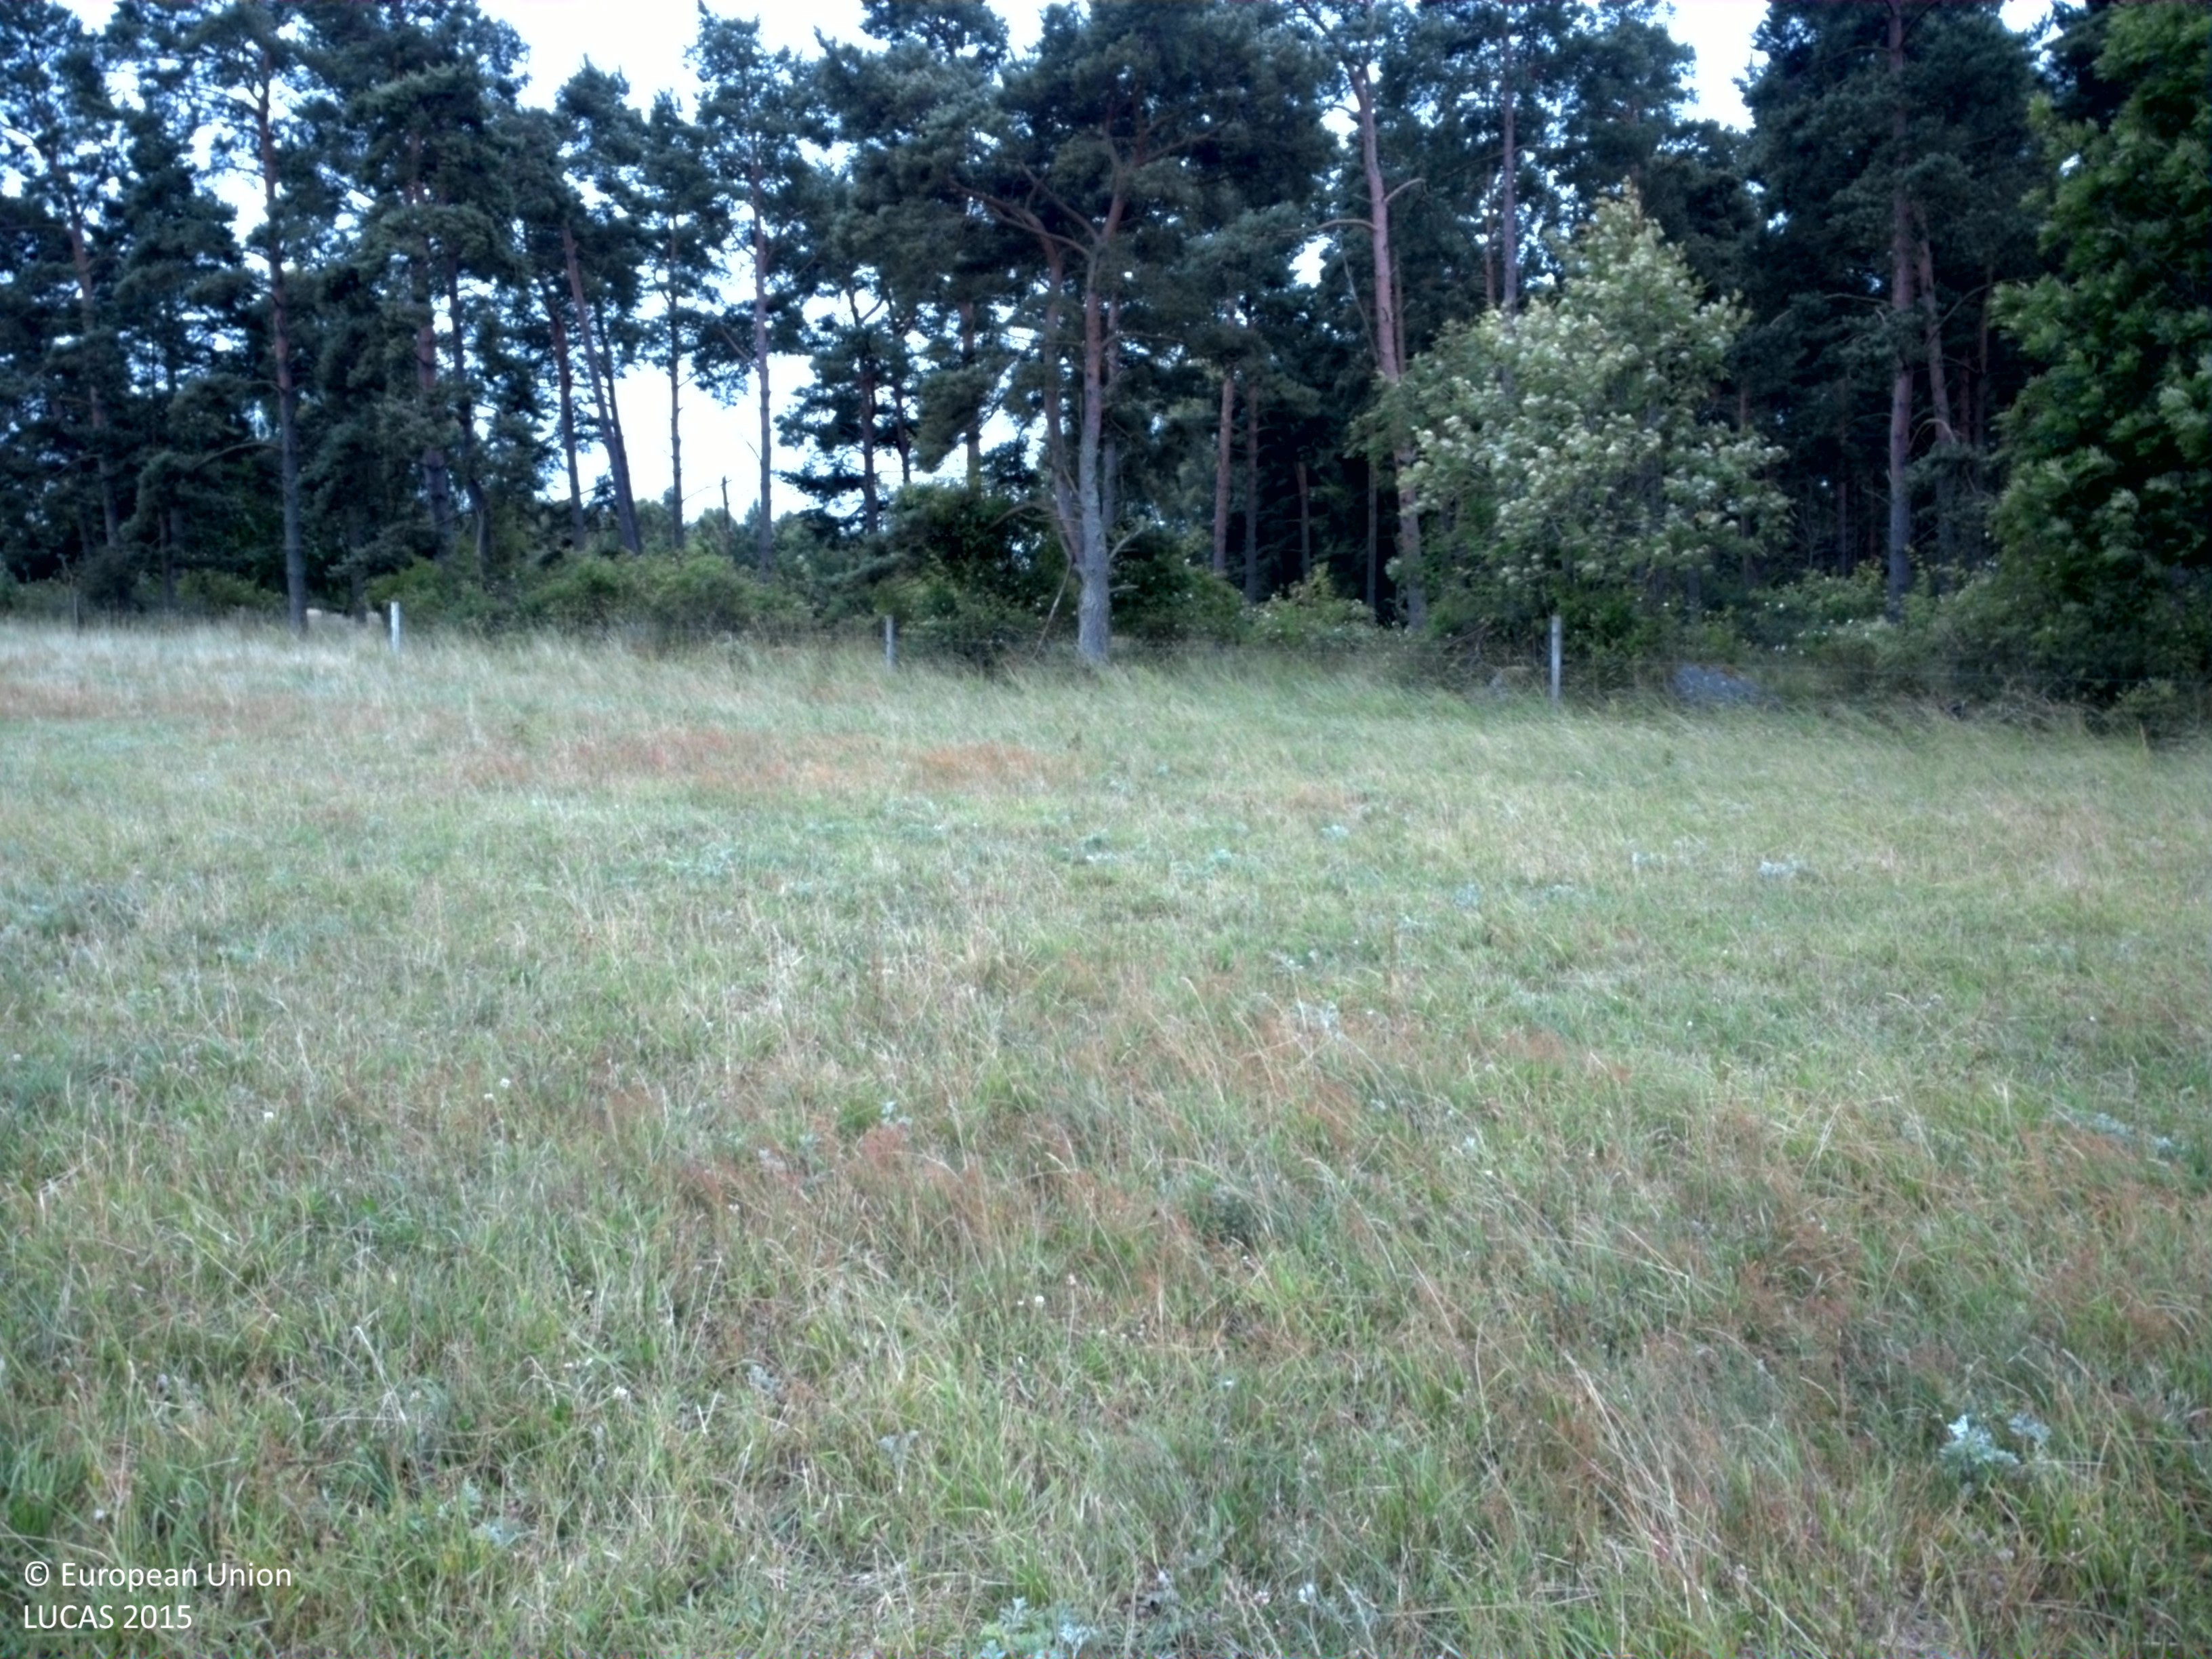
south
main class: Grassland
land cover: Grassland without tree/shrub cover
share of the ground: > 75 %
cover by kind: herbaceous plants 100 %
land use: Agriculture (excluding fallow land and kitchen gardens)
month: July
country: SE
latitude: 57.4470
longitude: 18.1549
